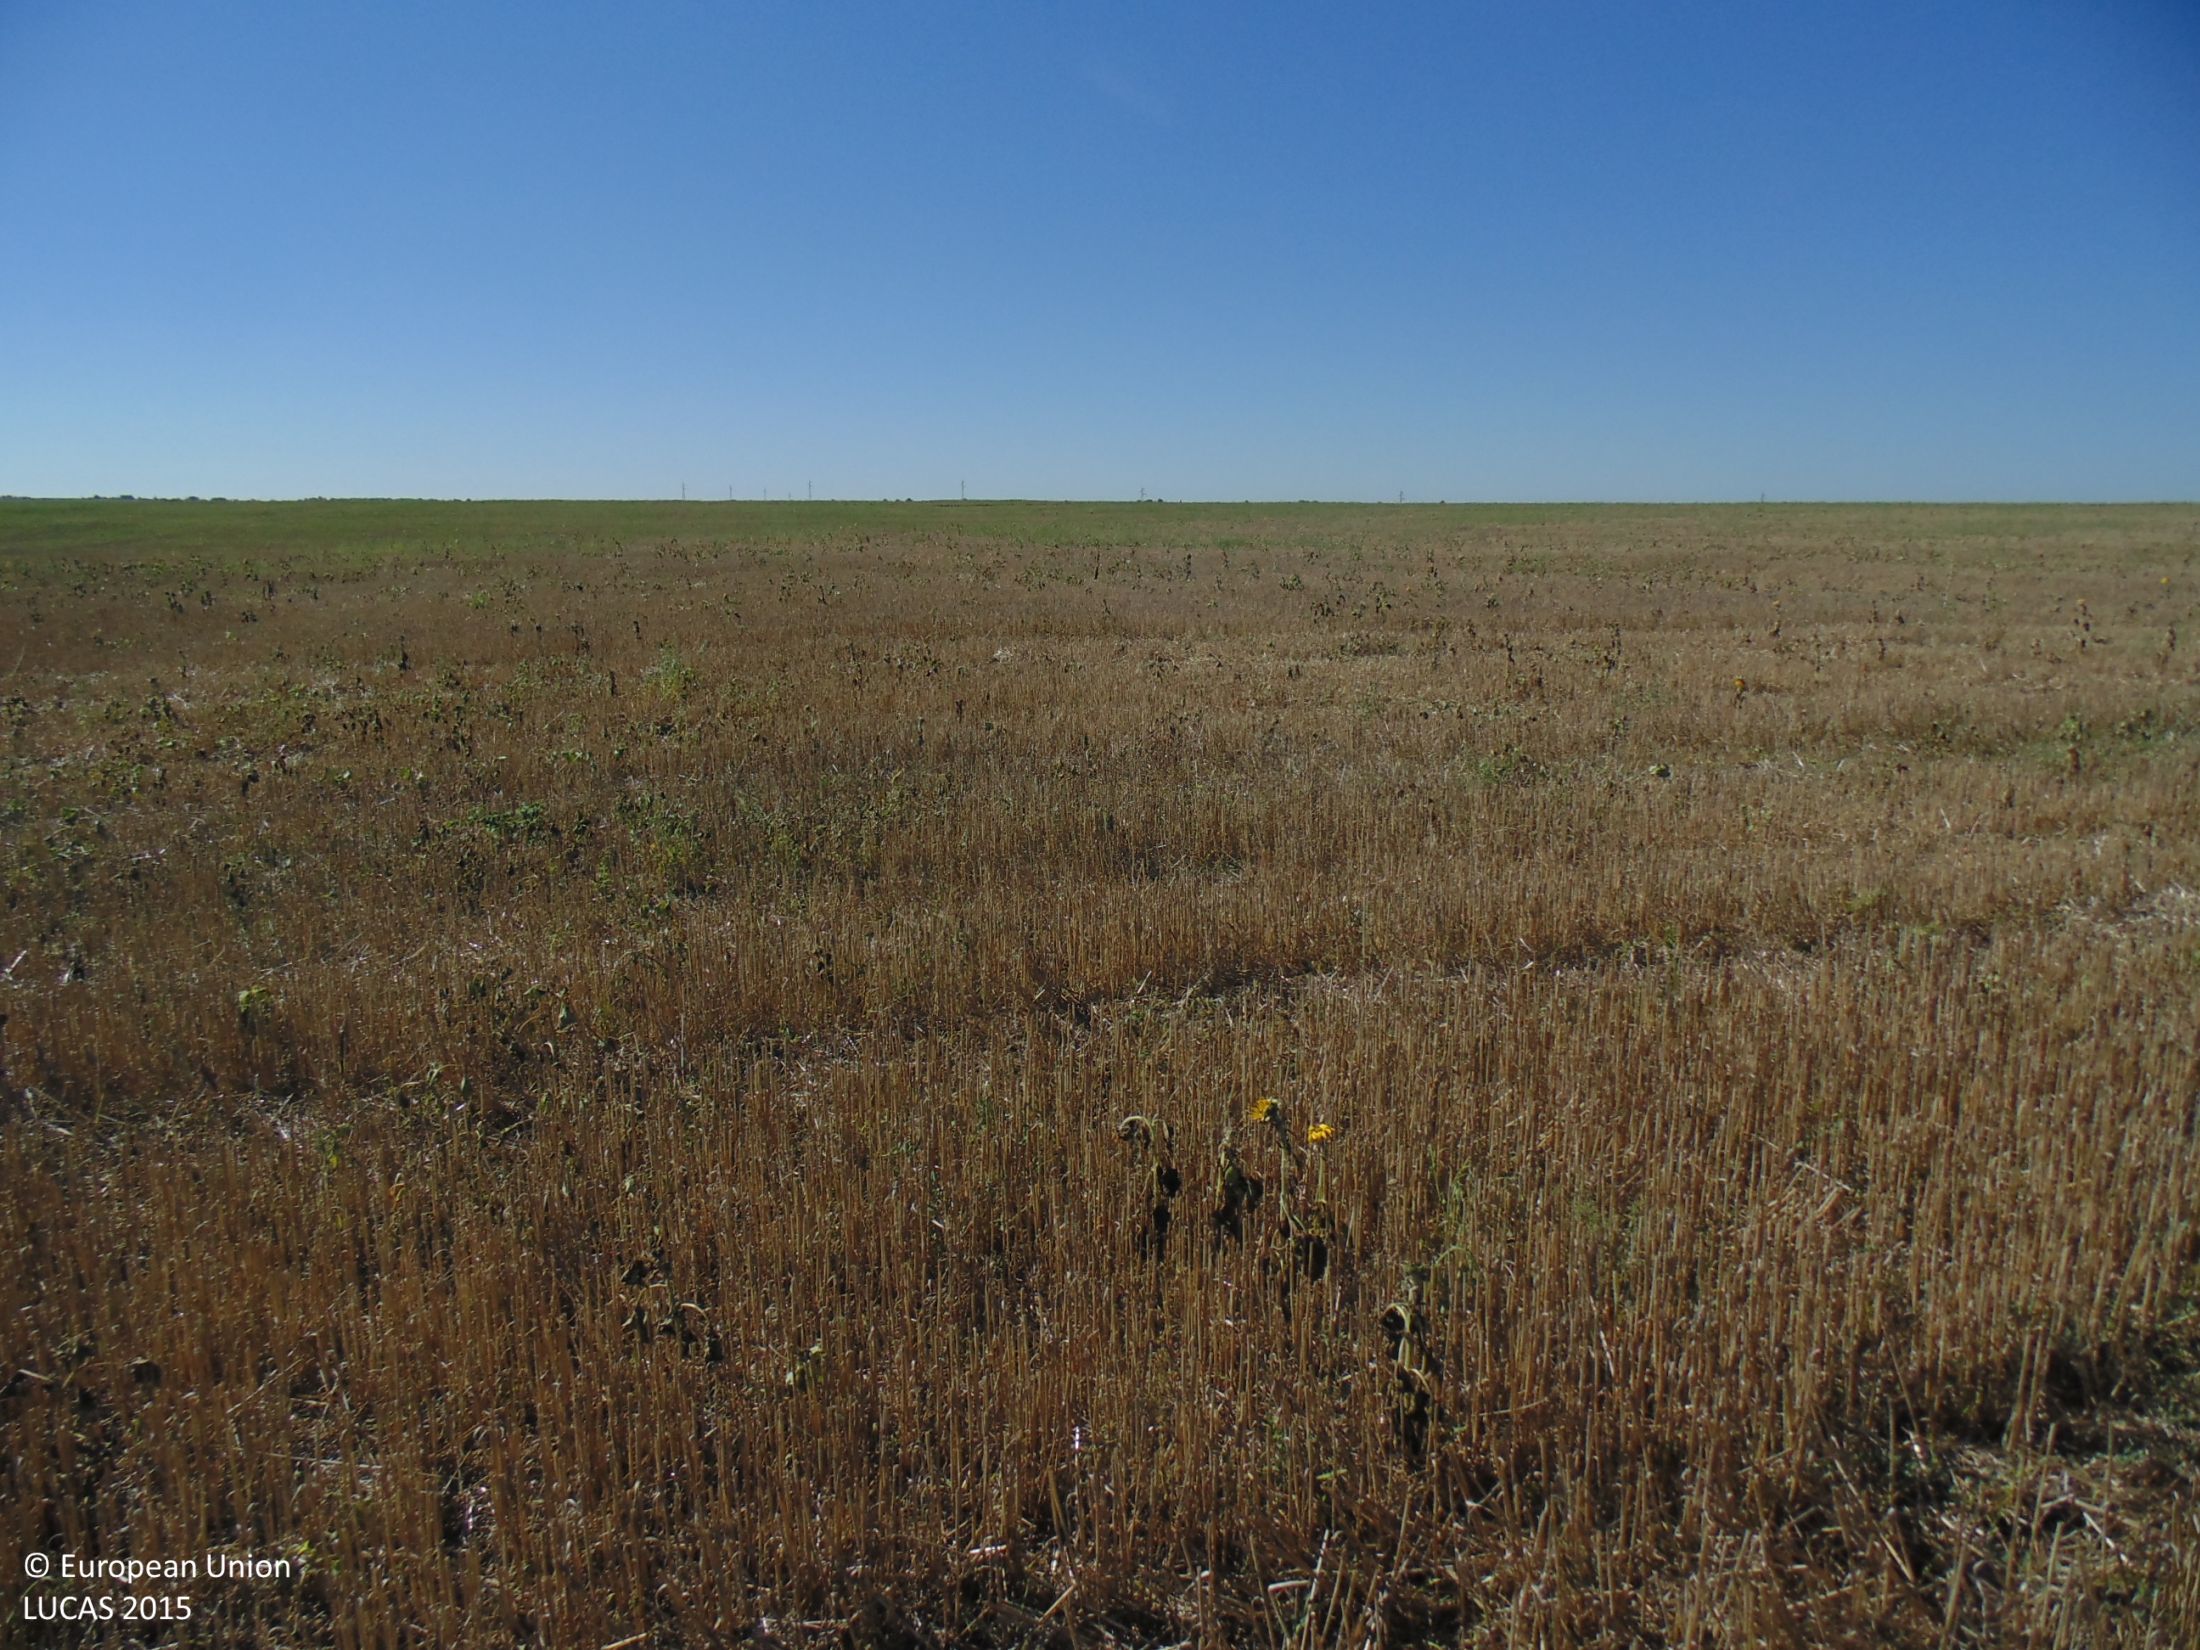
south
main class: Cropland
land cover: Common wheat
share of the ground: 50 - 75 %
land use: Agriculture (excluding fallow land and kitchen gardens)
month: September
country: BG
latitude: 43.8086
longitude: 27.1685
